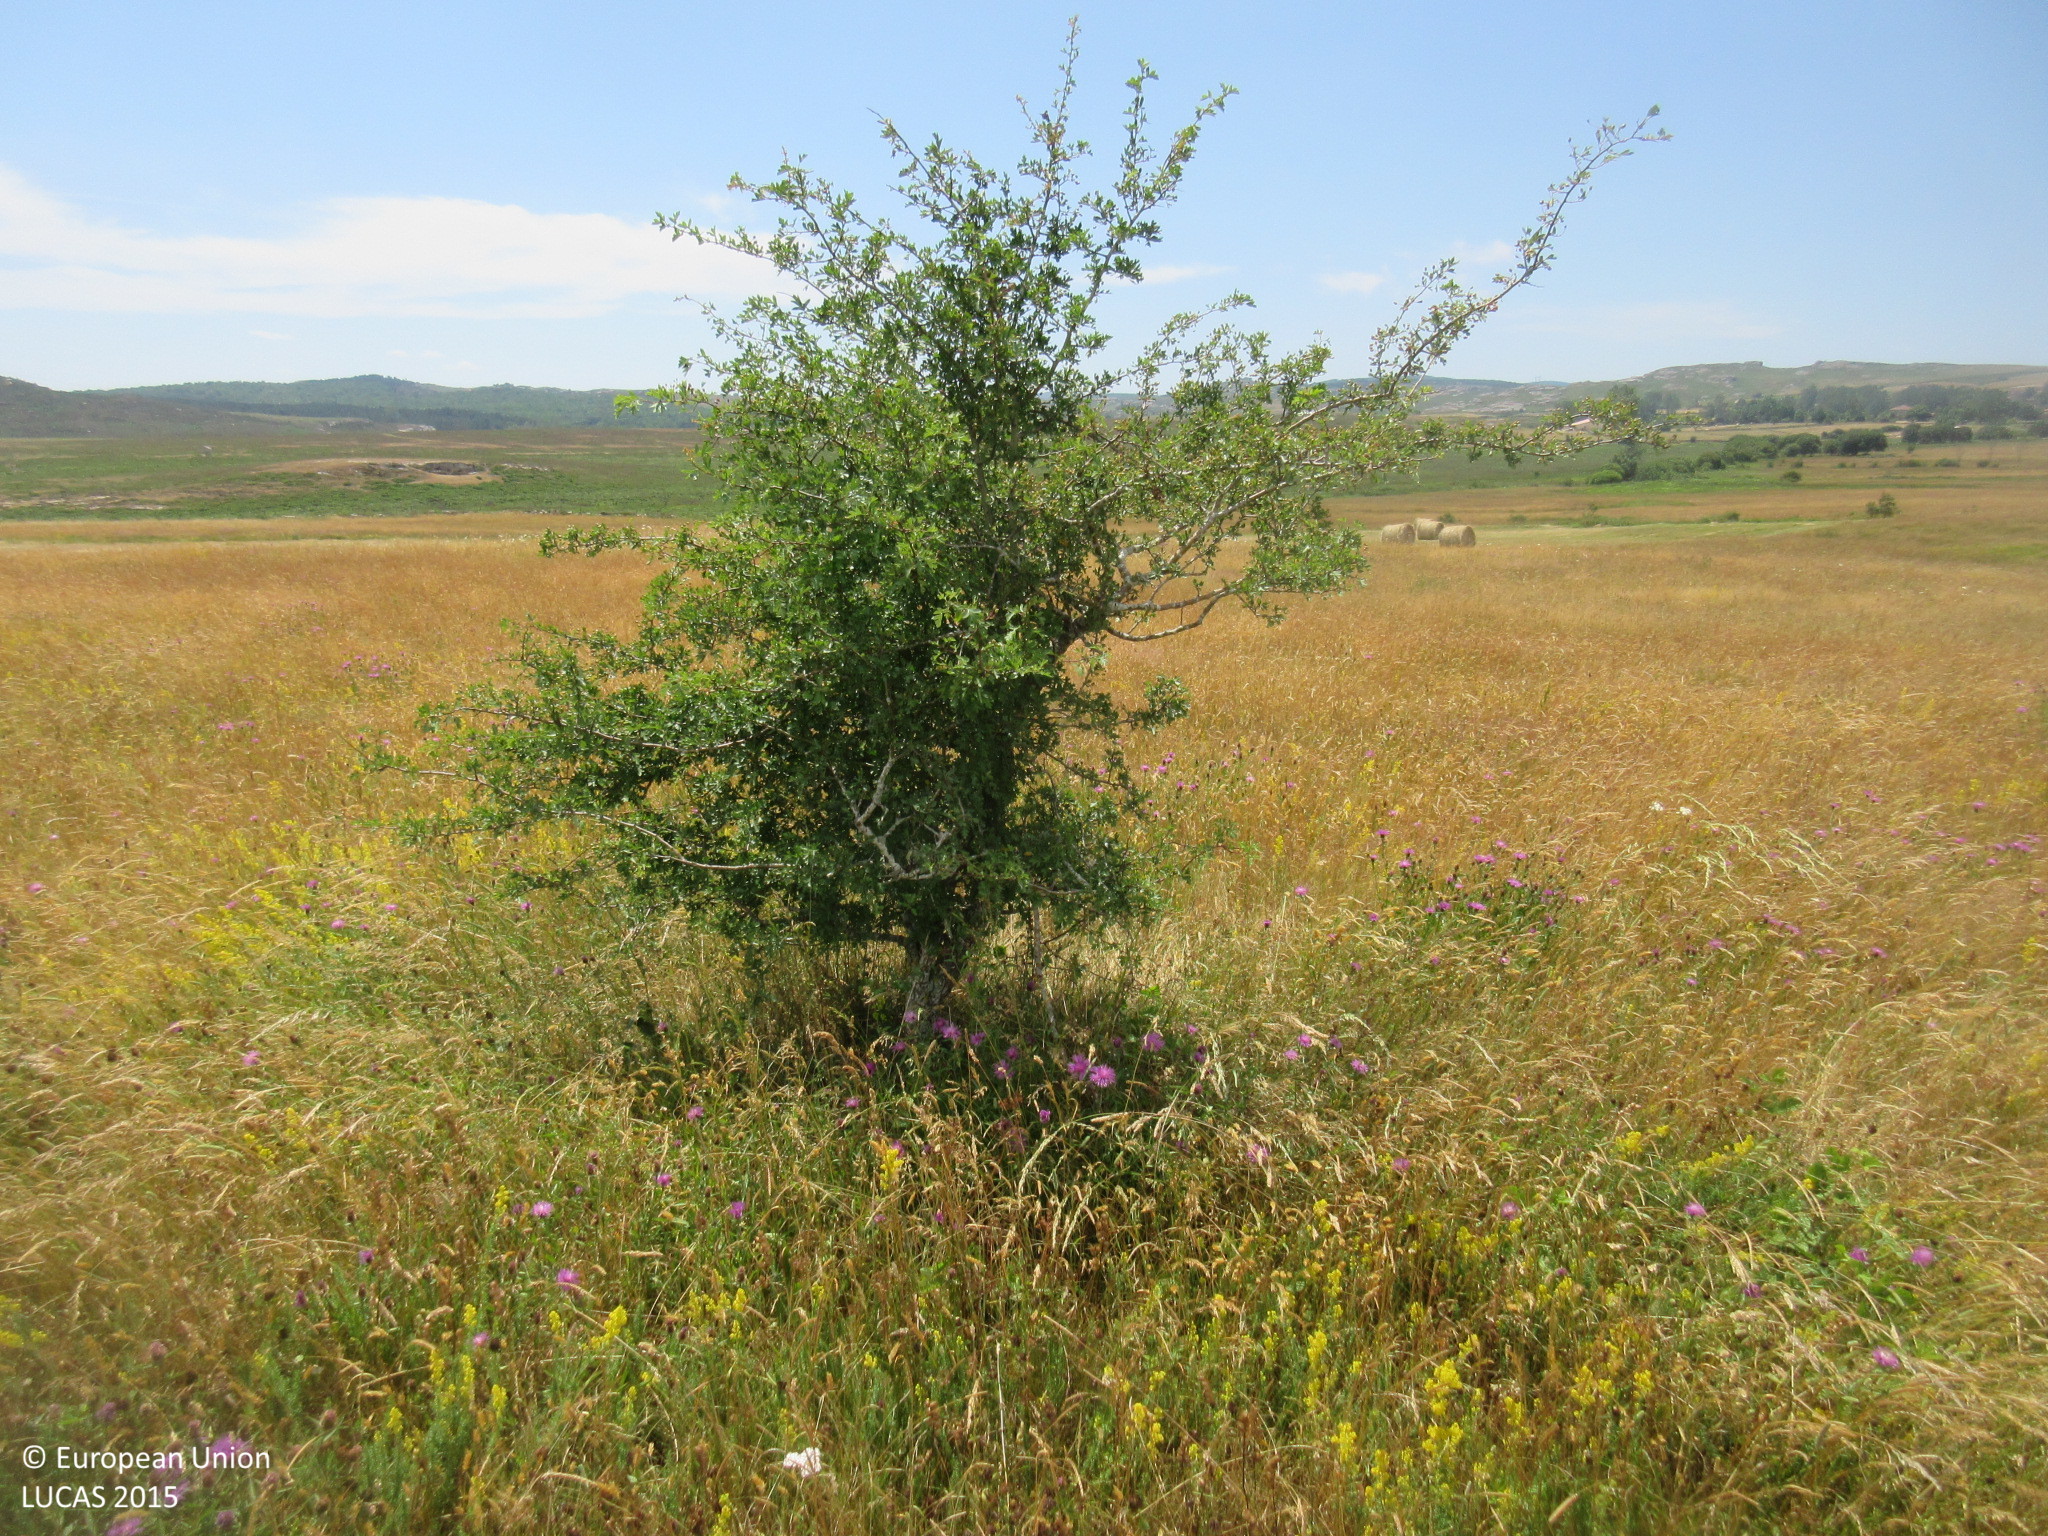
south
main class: Grassland
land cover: Spontaneously vegetated surfaces
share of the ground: > 75 %
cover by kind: herbaceous plants 100 %
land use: Agriculture (excluding fallow land and kitchen gardens)
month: July
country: ES
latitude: 42.9658
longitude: -3.9370
